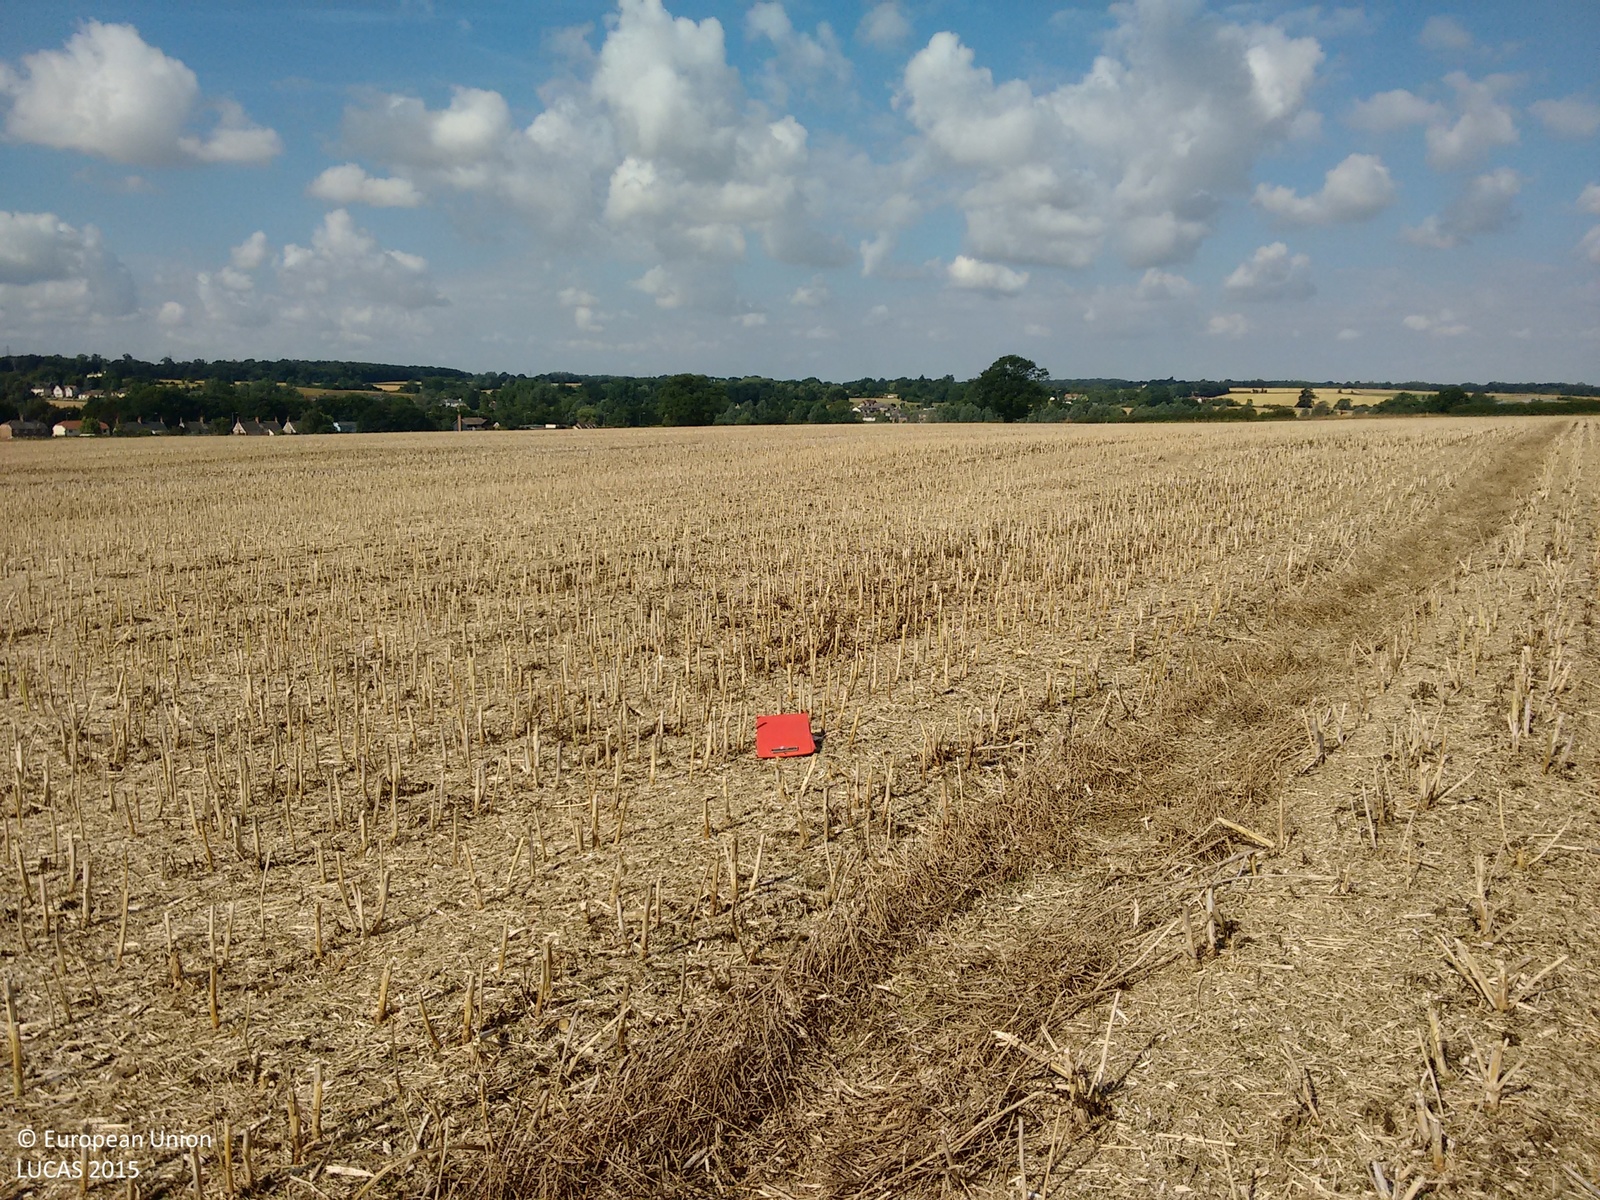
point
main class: Cropland
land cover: Rape and turnip rape
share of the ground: 25 - 50 %
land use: Agriculture (excluding fallow land and kitchen gardens)
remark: Harvested field
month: July
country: GB
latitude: 51.8797
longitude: 0.6327
